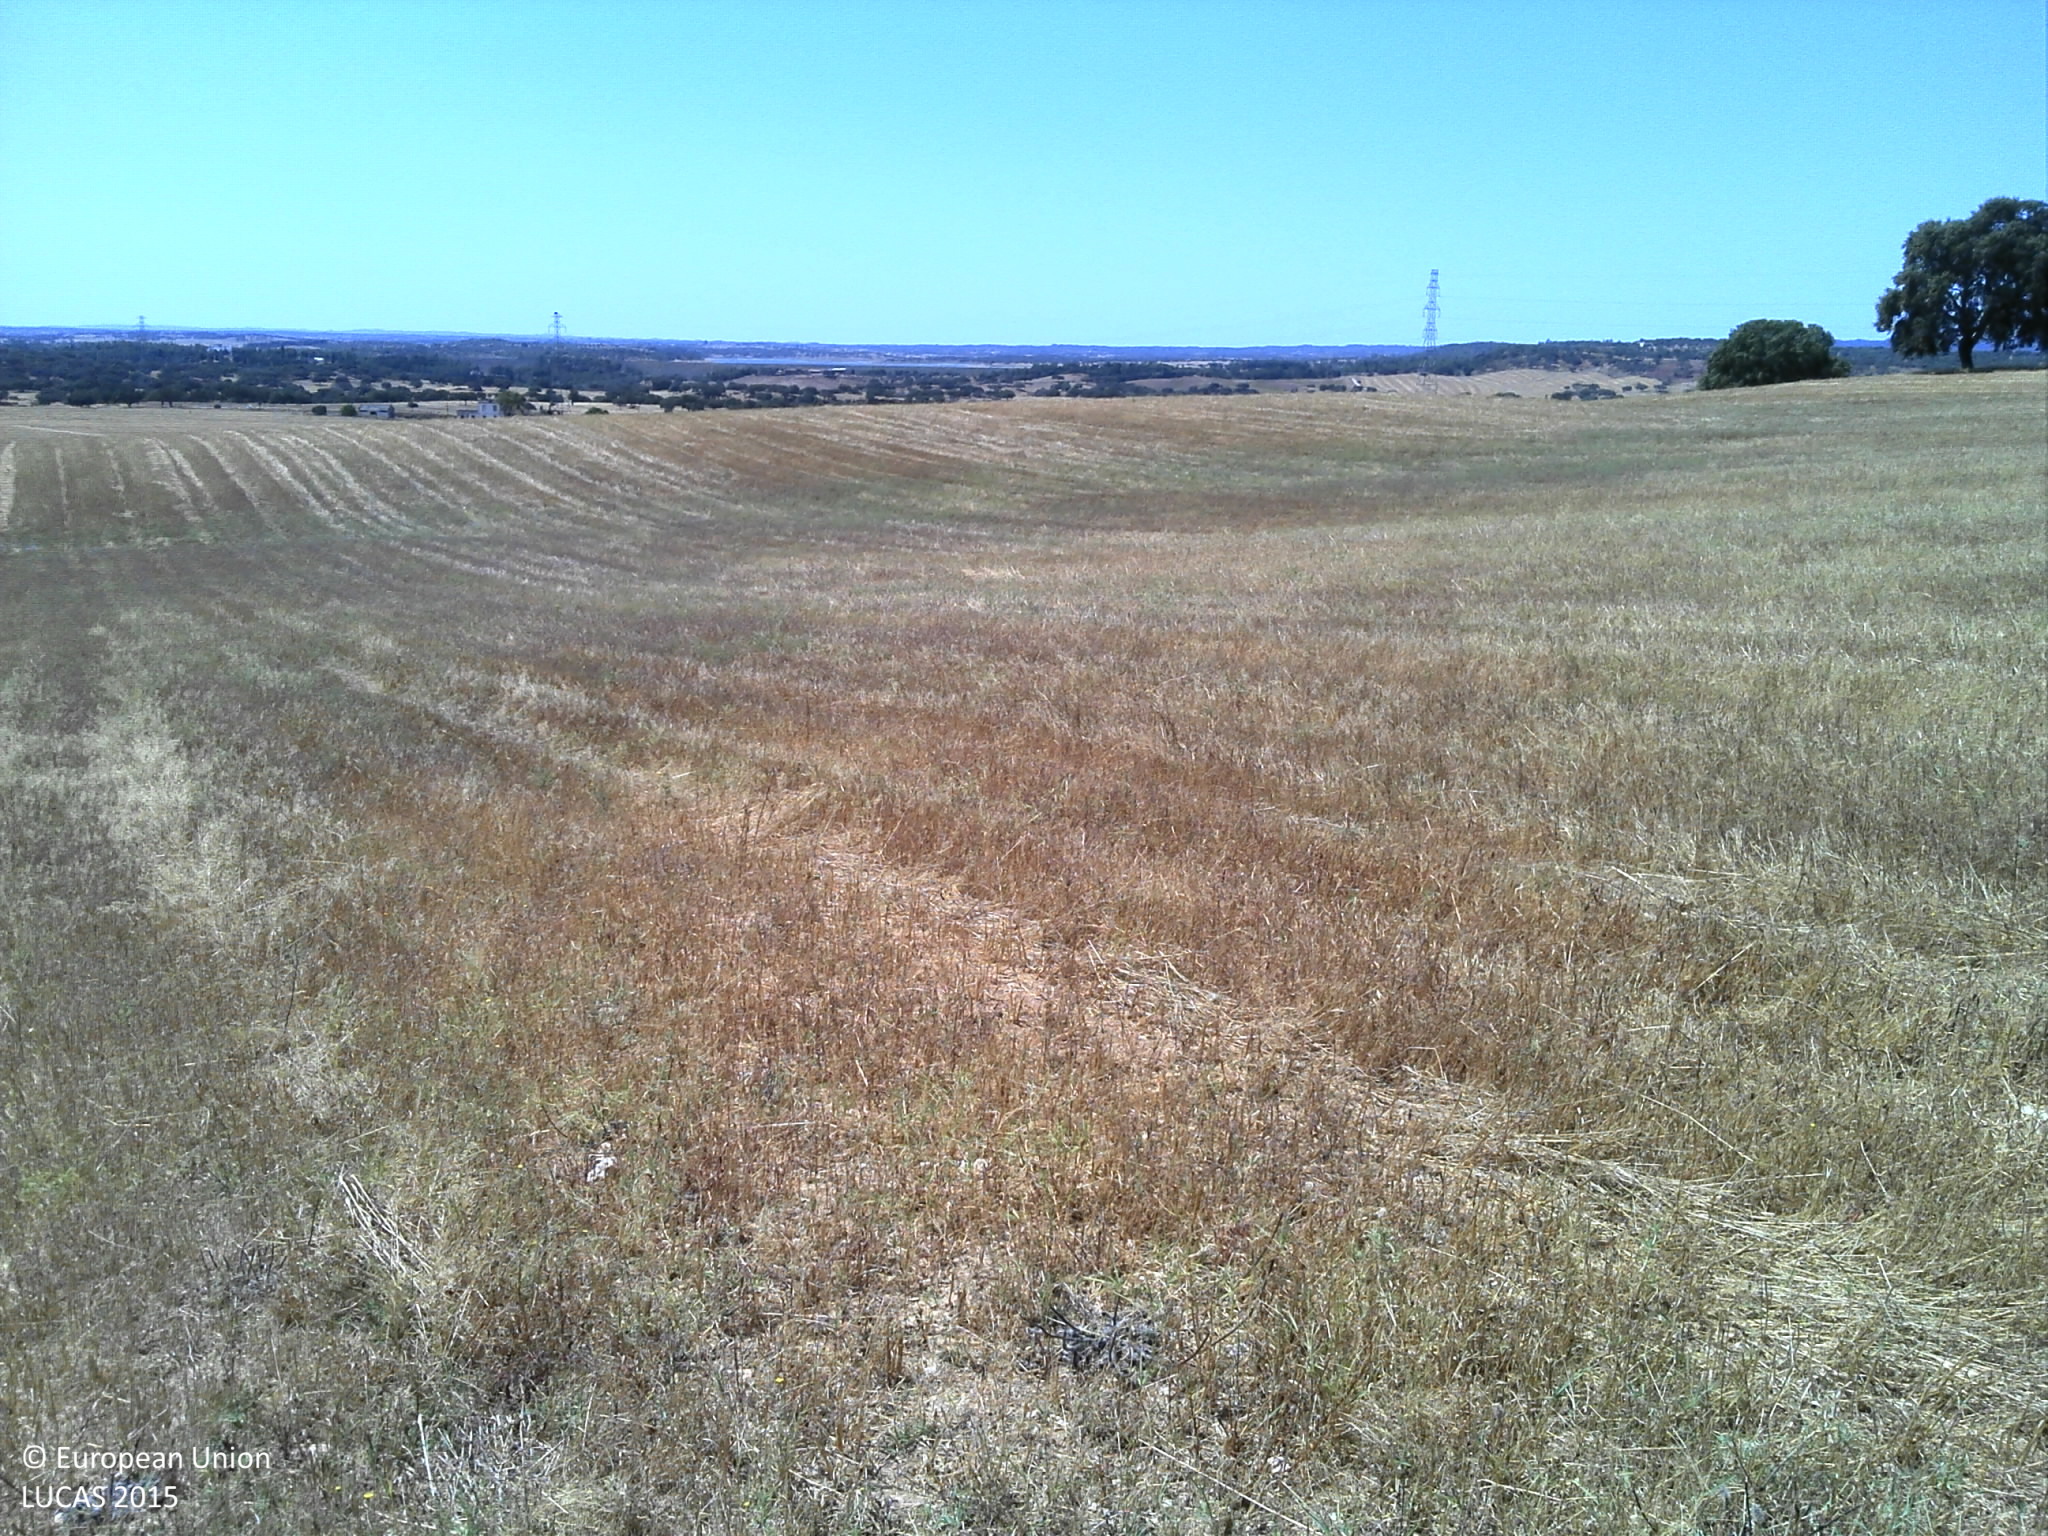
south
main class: Grassland
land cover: Spontaneously vegetated surfaces
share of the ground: 50 - 75 %
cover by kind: herbaceous plants 50 %, consolidated bare surface 50 %
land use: Agriculture (excluding fallow land and kitchen gardens)
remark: Harvested field
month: July
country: PT
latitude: 37.7532
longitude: -8.2948
